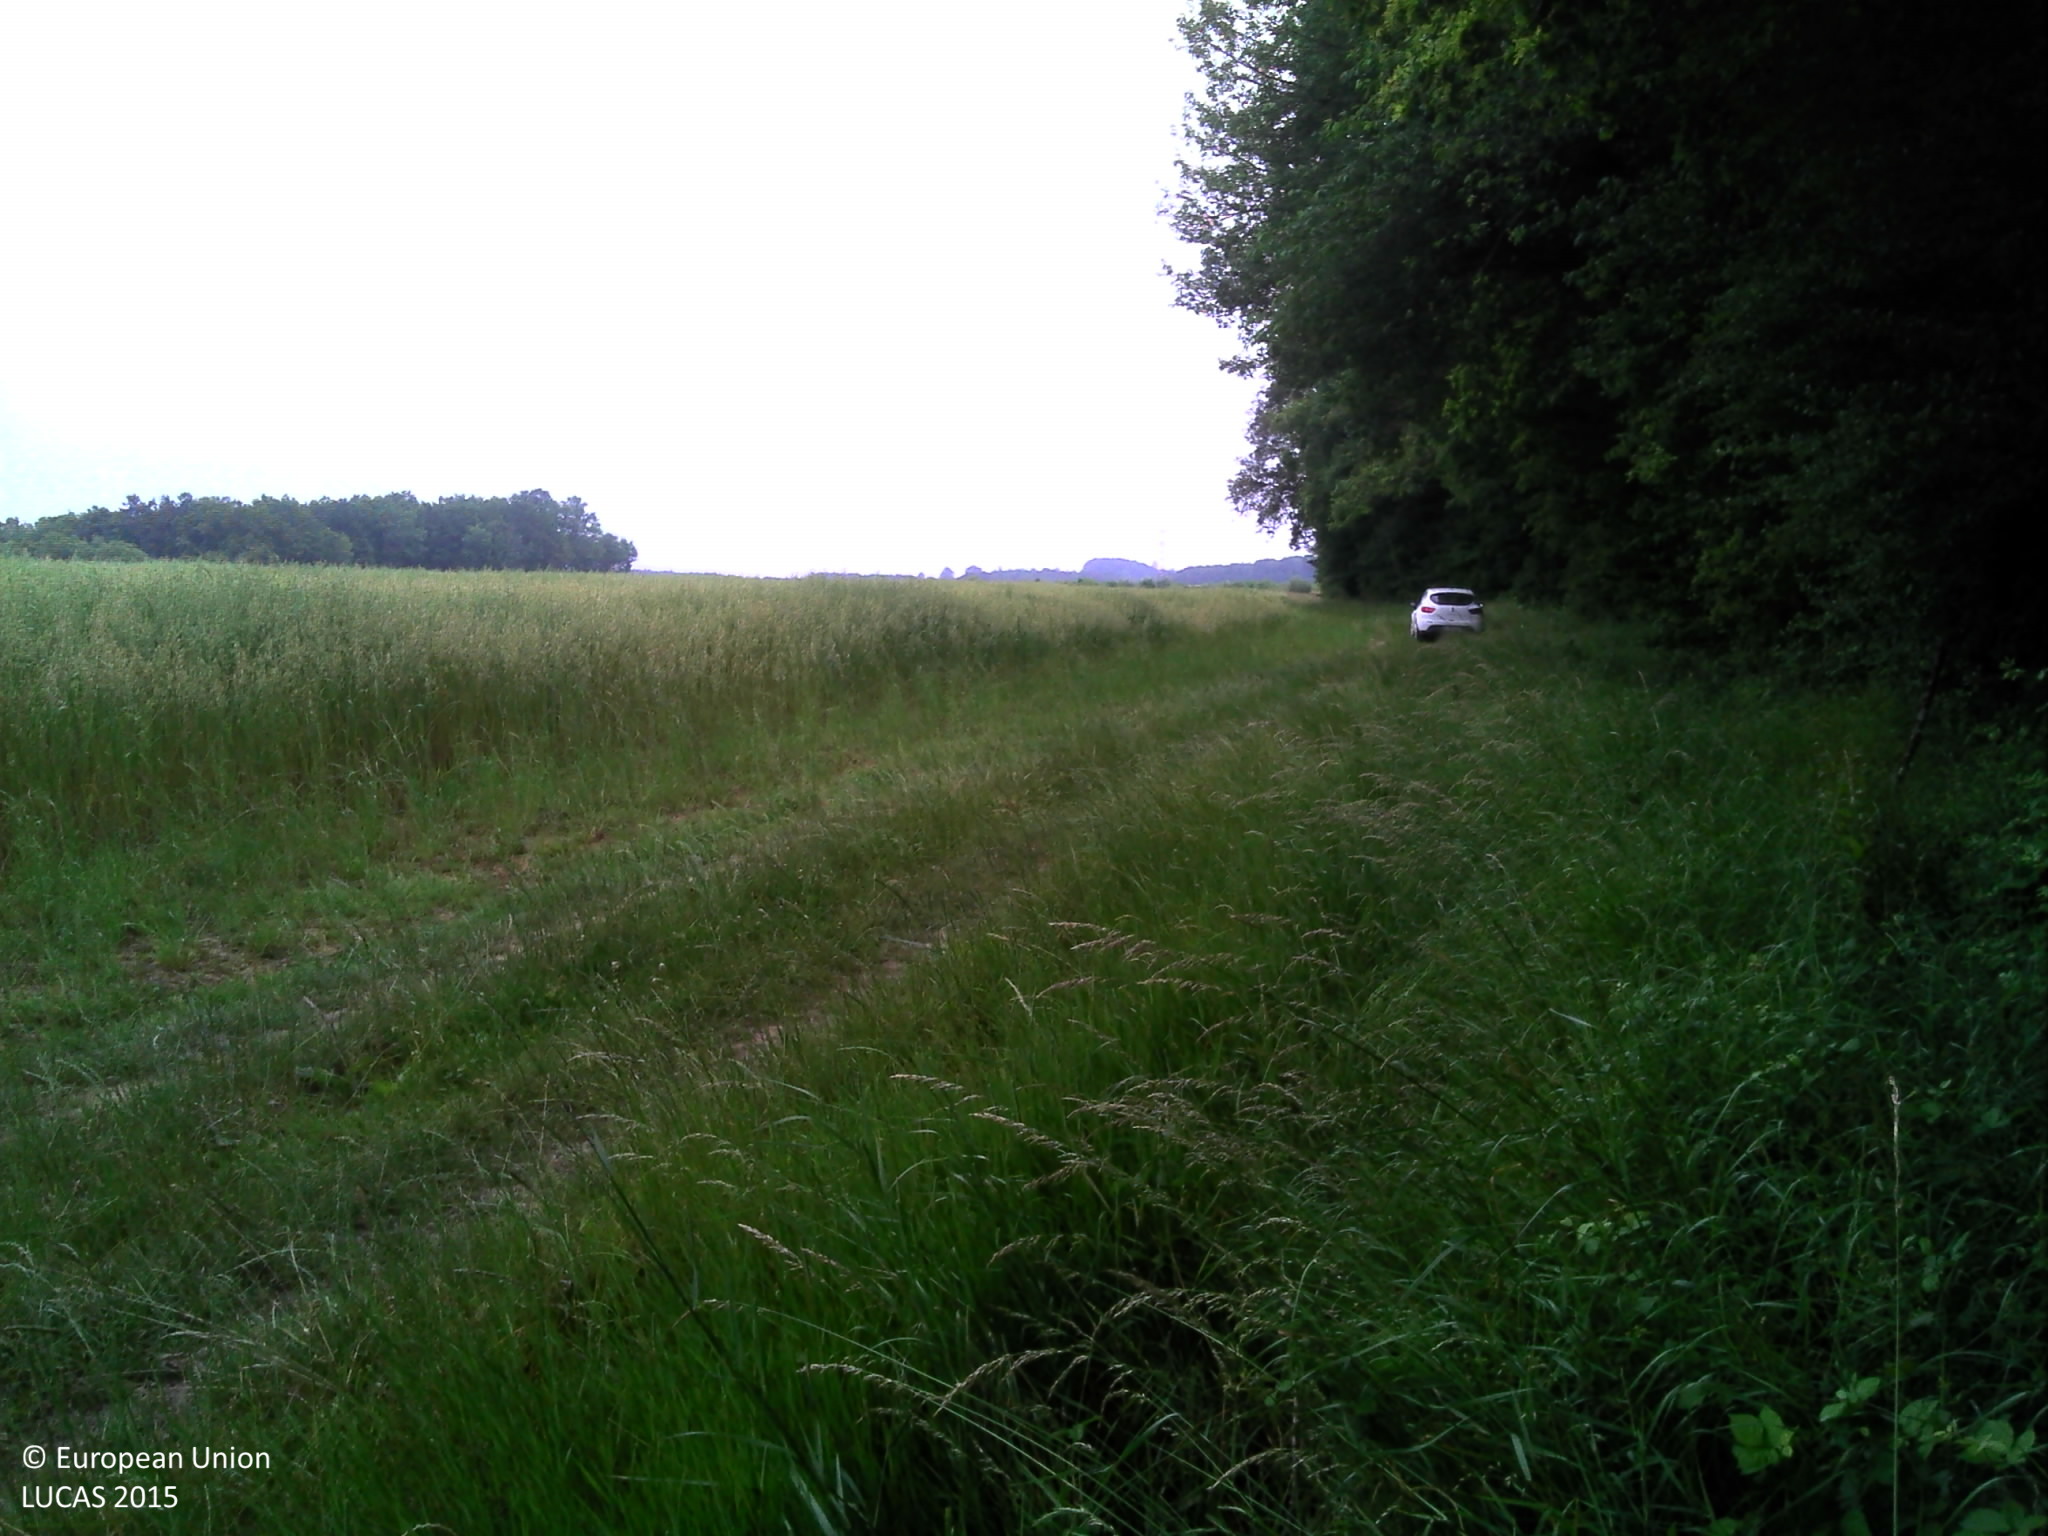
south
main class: Cropland
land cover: Oats
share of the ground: > 75 %
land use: Agriculture (excluding fallow land and kitchen gardens)
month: June
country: FR
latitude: 47.9242
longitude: 3.8267
